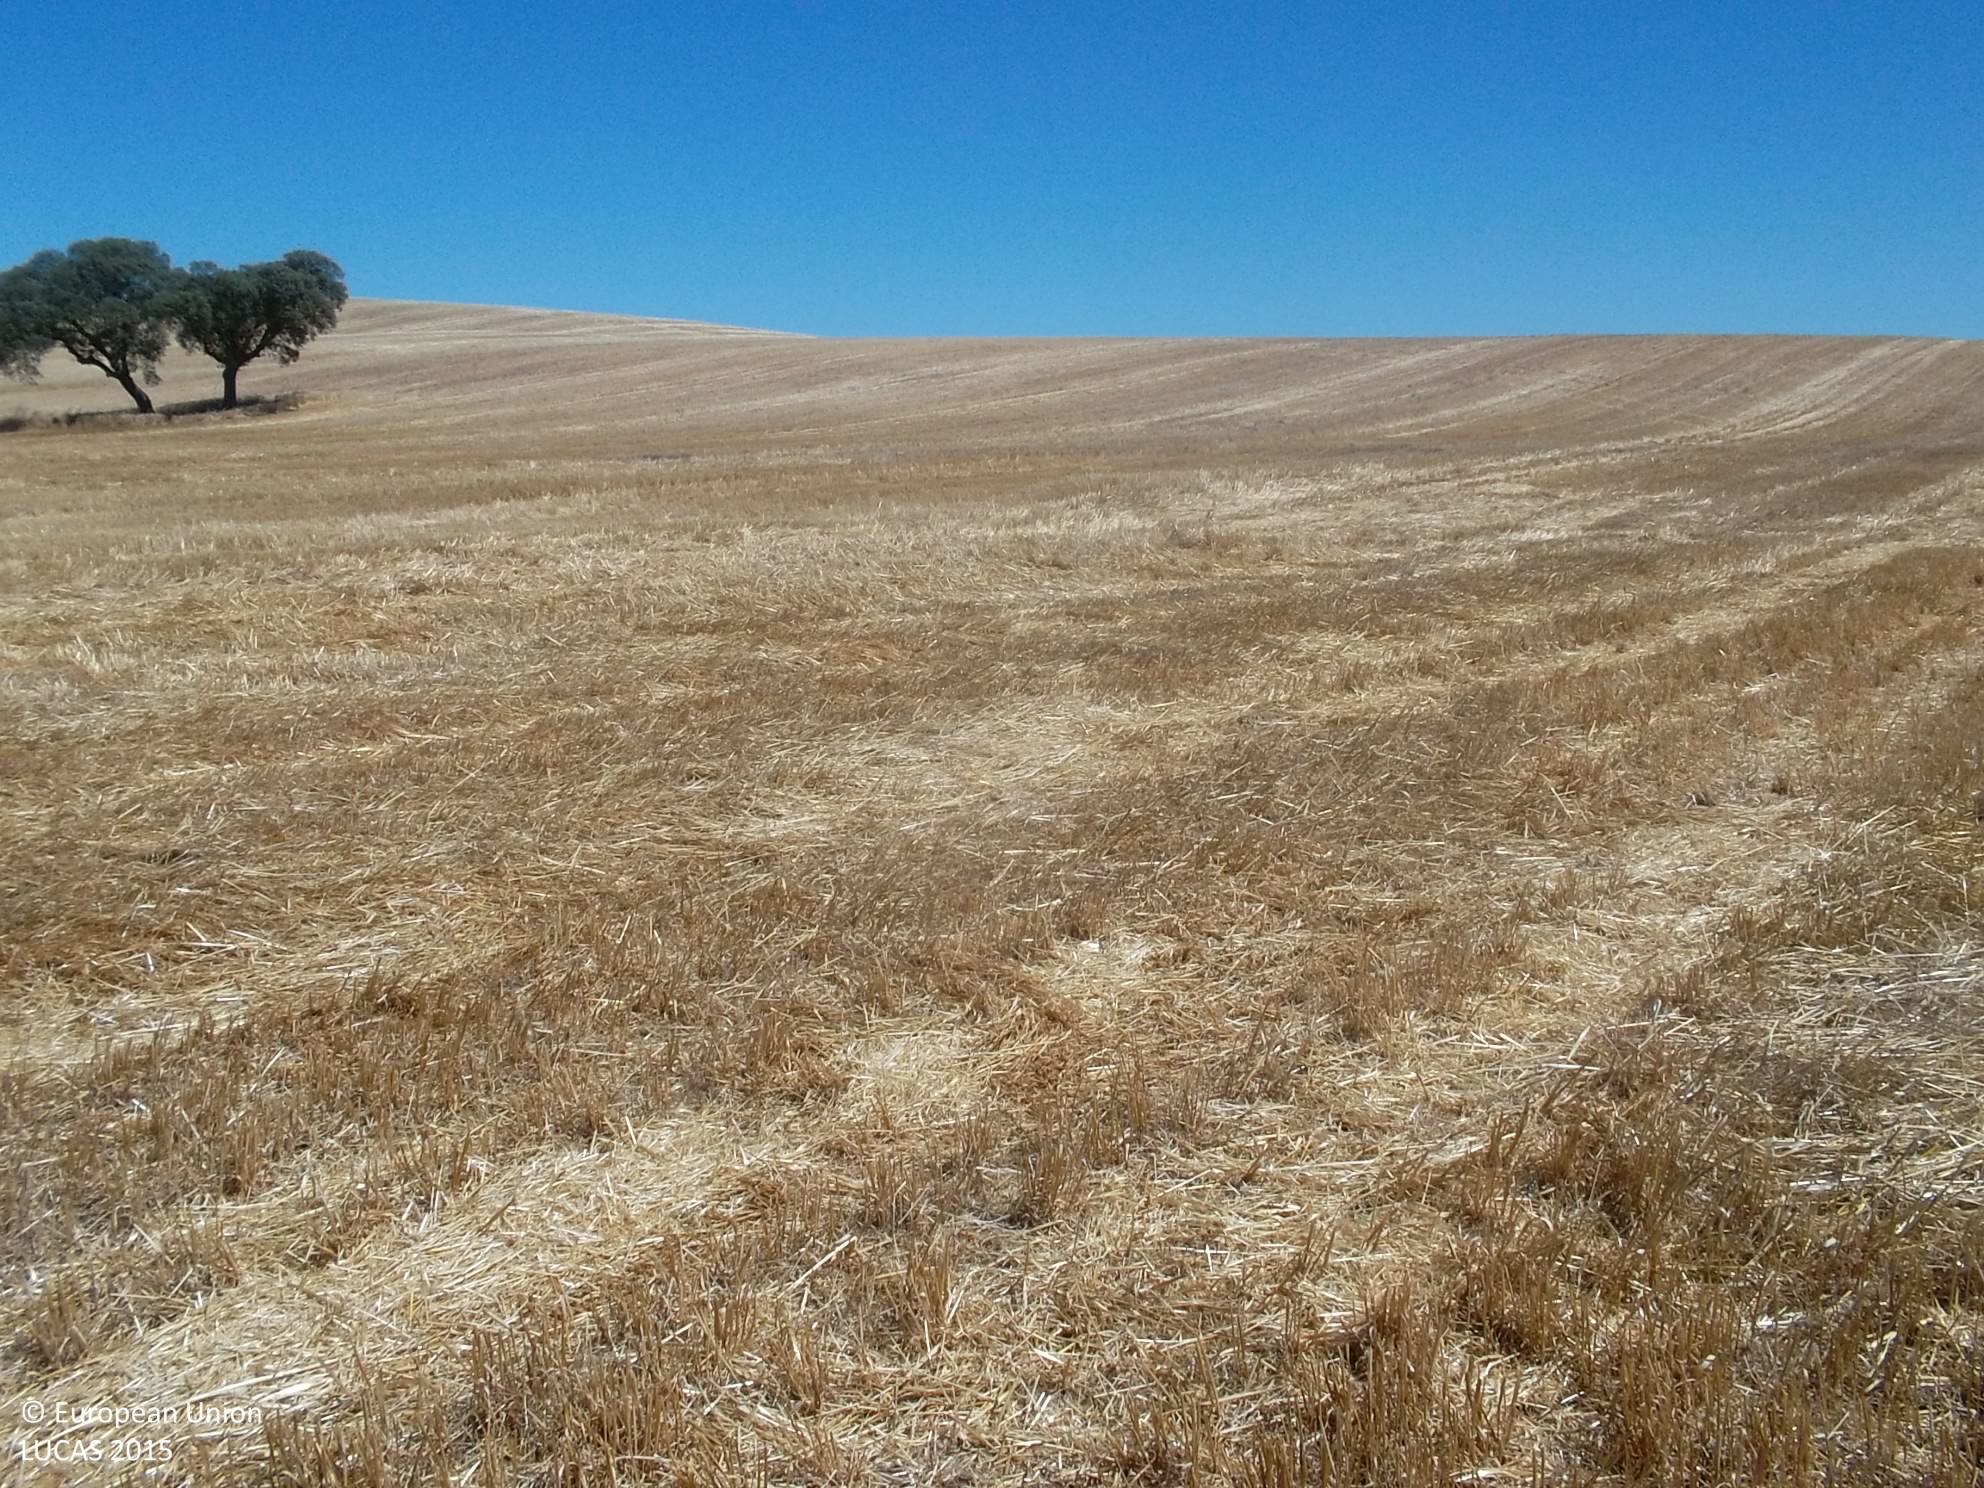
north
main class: Cropland
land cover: Barley
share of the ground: < 10 %
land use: Agriculture (excluding fallow land and kitchen gardens)
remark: Harvested field
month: July
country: ES
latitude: 38.4173
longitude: -5.7405
